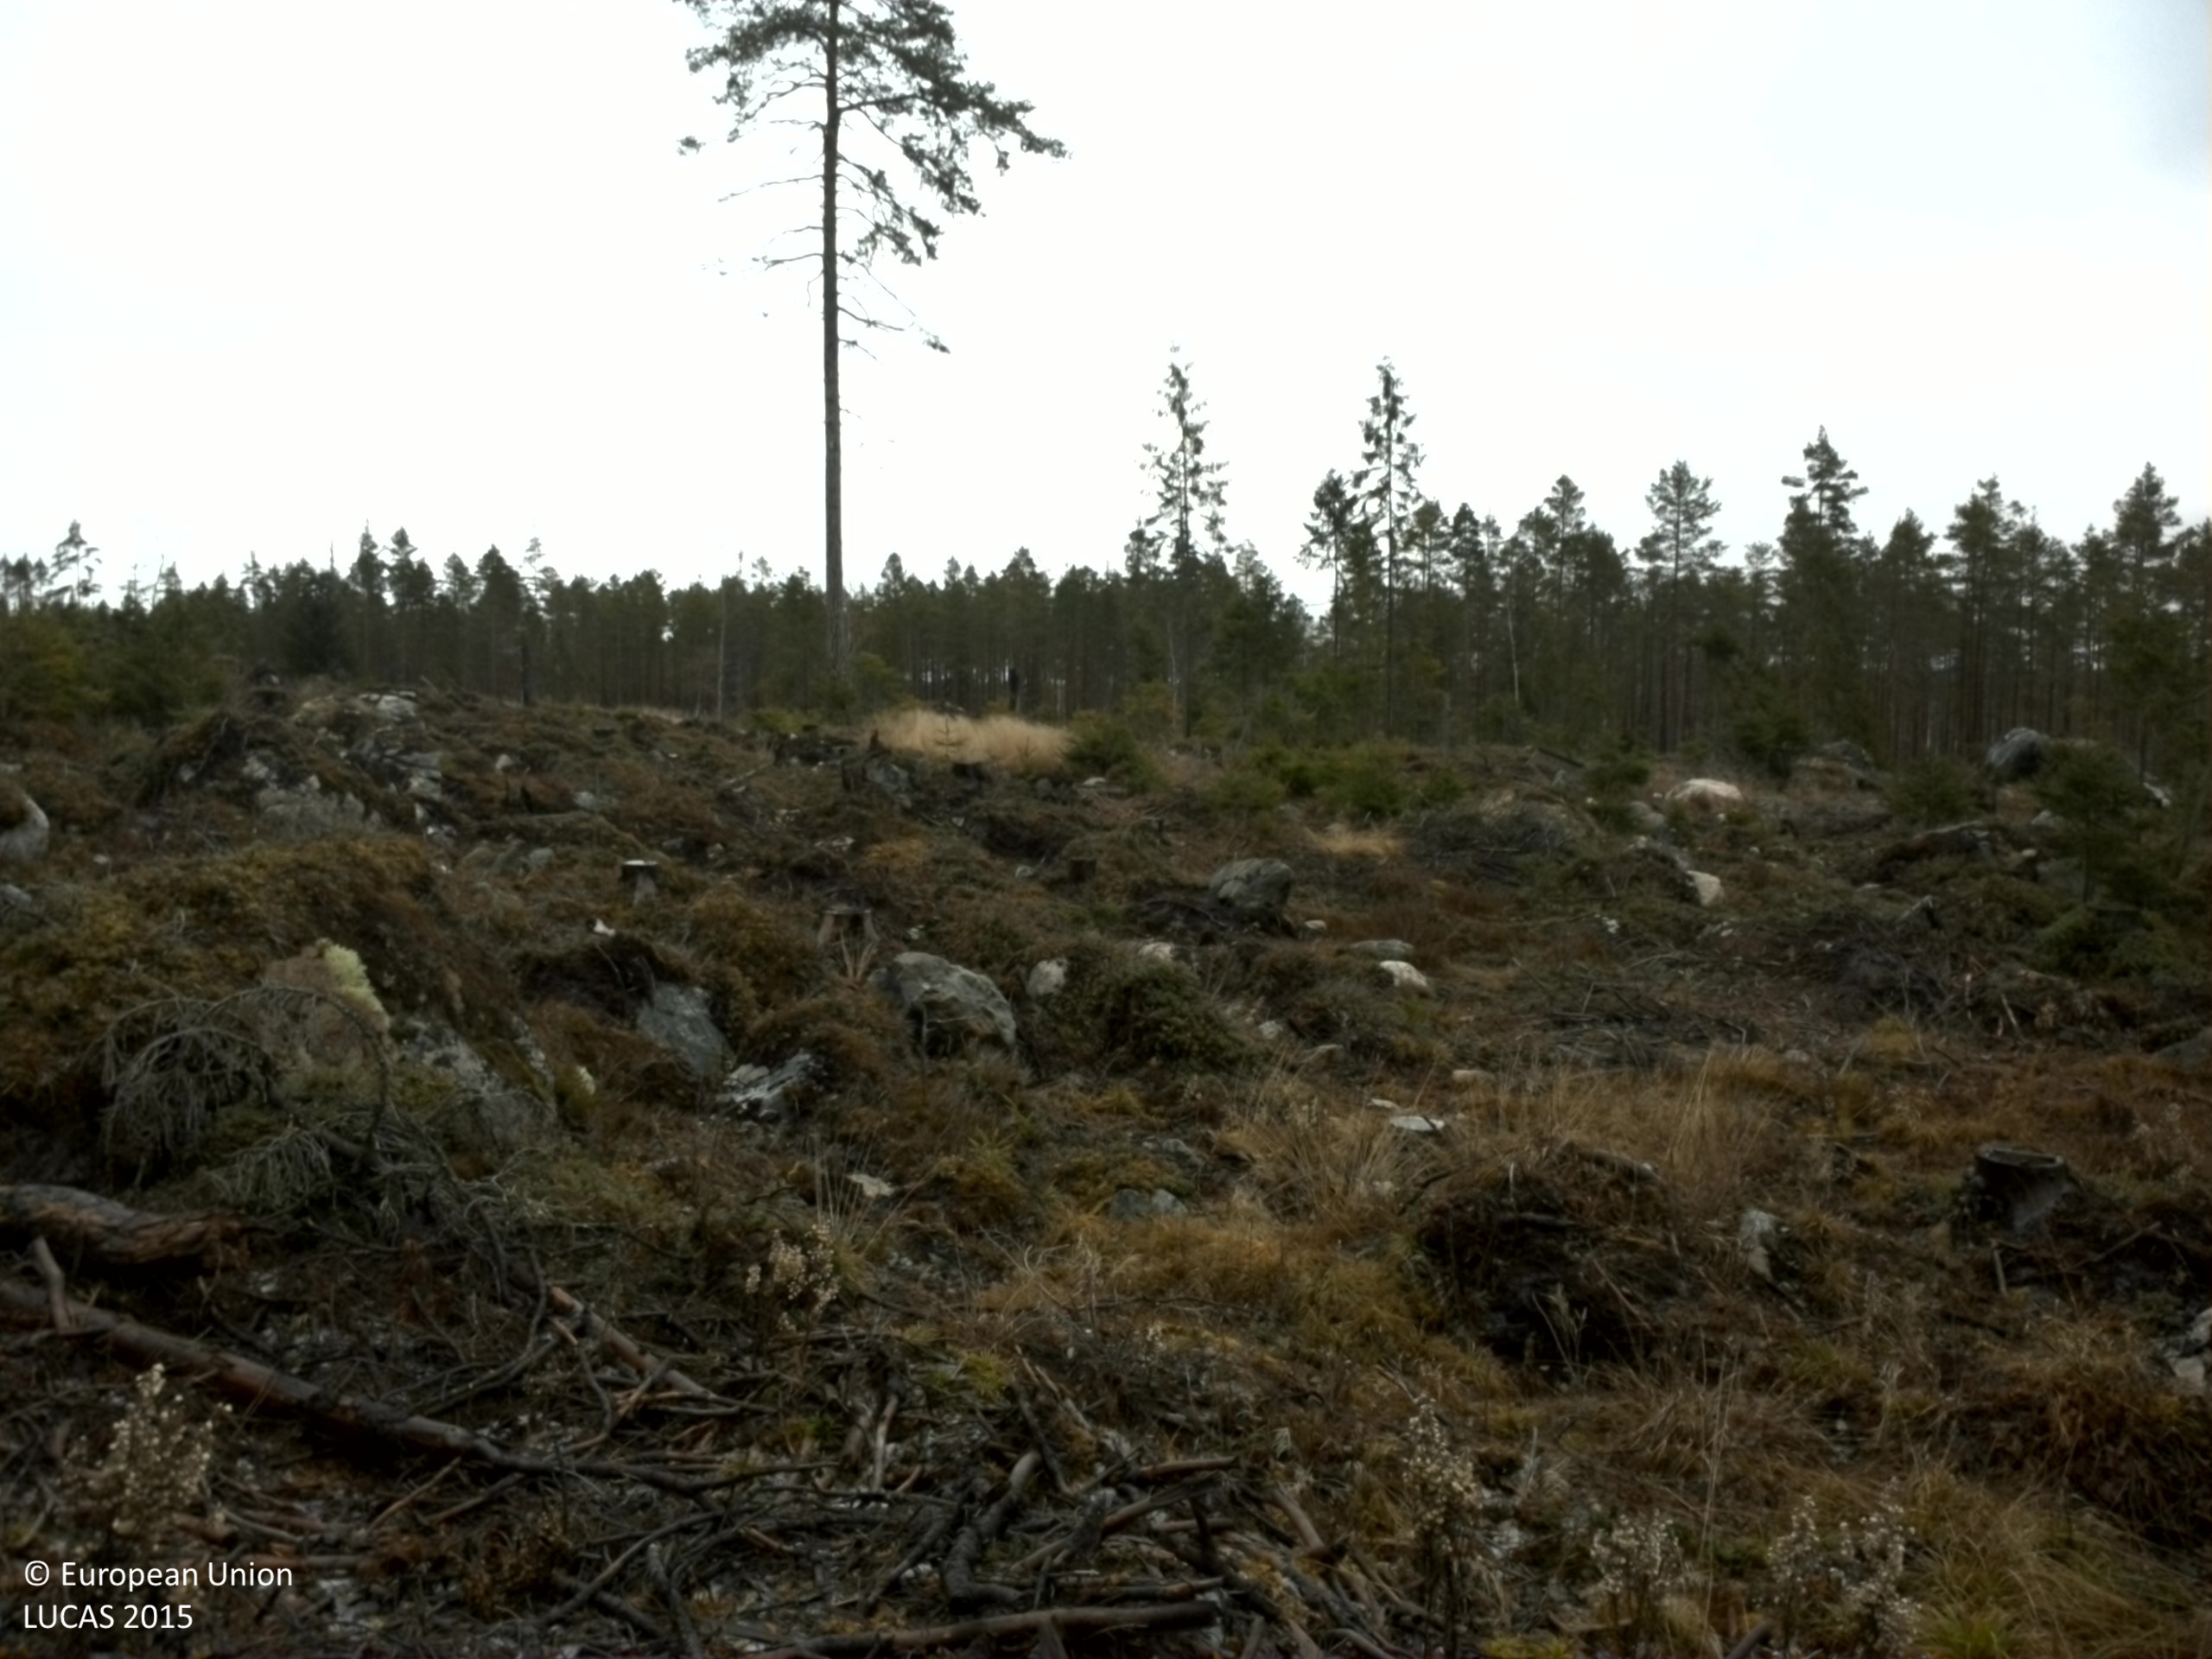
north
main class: Woodland
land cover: Spruce dominated mixed woodland
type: boreal forest
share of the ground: 10 - 25 %
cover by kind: shrubs 35 %, herbaceous plants 20 %, lichens and mosses 20 %, coniferous forest trees 10 %, consolidated bare surface 10 %, broadleaved forest trees 5 %
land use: Forestry
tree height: < 5 m
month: November
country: SE
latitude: 61.4300
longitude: 15.4389
